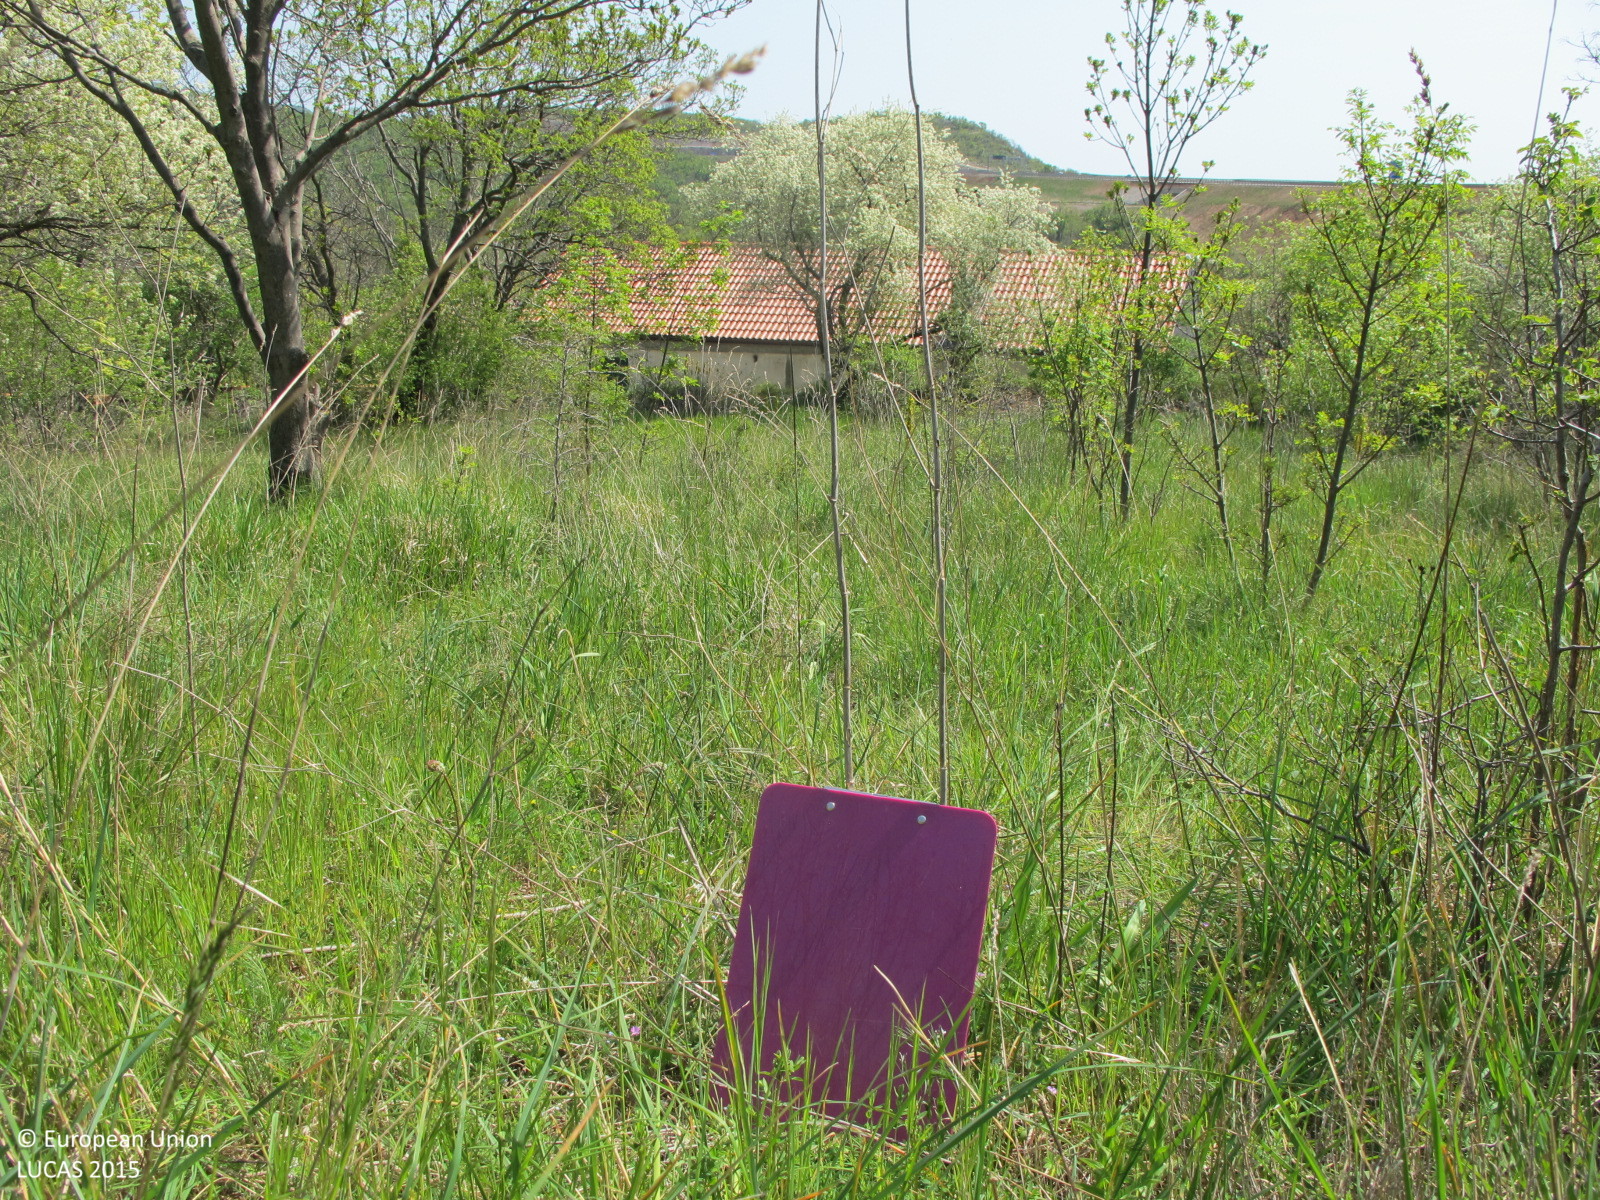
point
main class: Grassland
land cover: Grassland with sparse tree/shrub cover
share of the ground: > 75 %
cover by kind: herbaceous plants 70 %, shrubs 10 %, broadleaved forest trees 5 %
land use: Abandoned areas
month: April
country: HR
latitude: 45.2971
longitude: 14.5729
